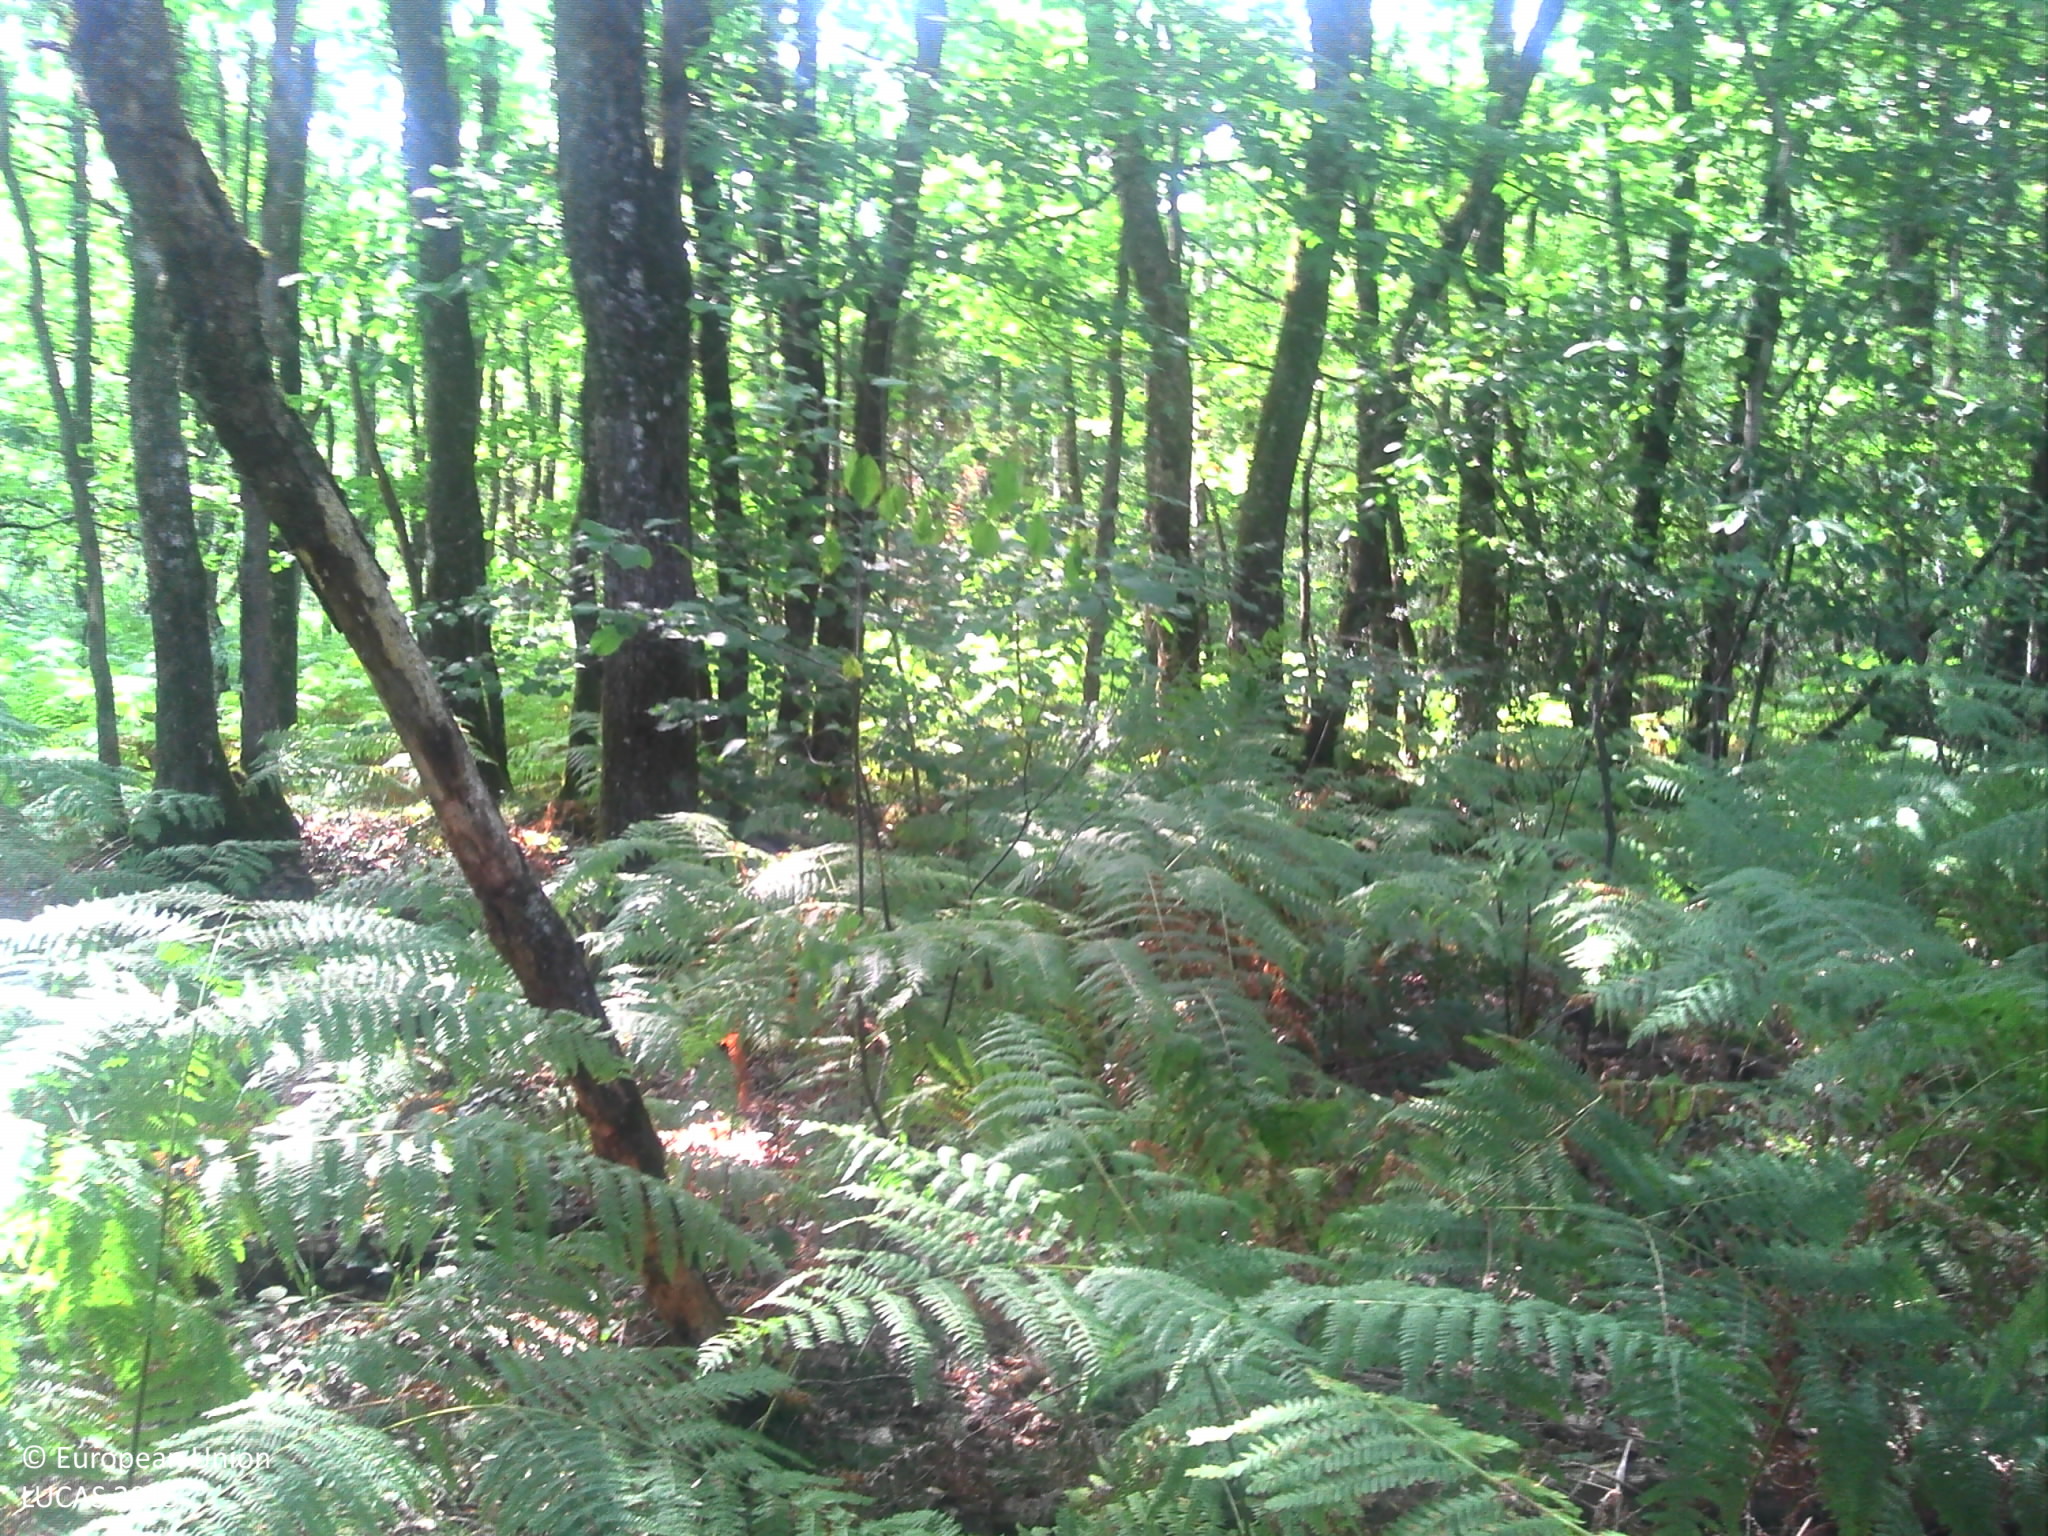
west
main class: Woodland
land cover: Broadleaved woodland
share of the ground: > 75 %
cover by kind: broadleaved forest trees 95 %, coniferous forest trees 5 %
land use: Semi-natural and natural areas not in use
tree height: > 5 m
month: August
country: FR
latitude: 46.0978
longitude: 0.9980
